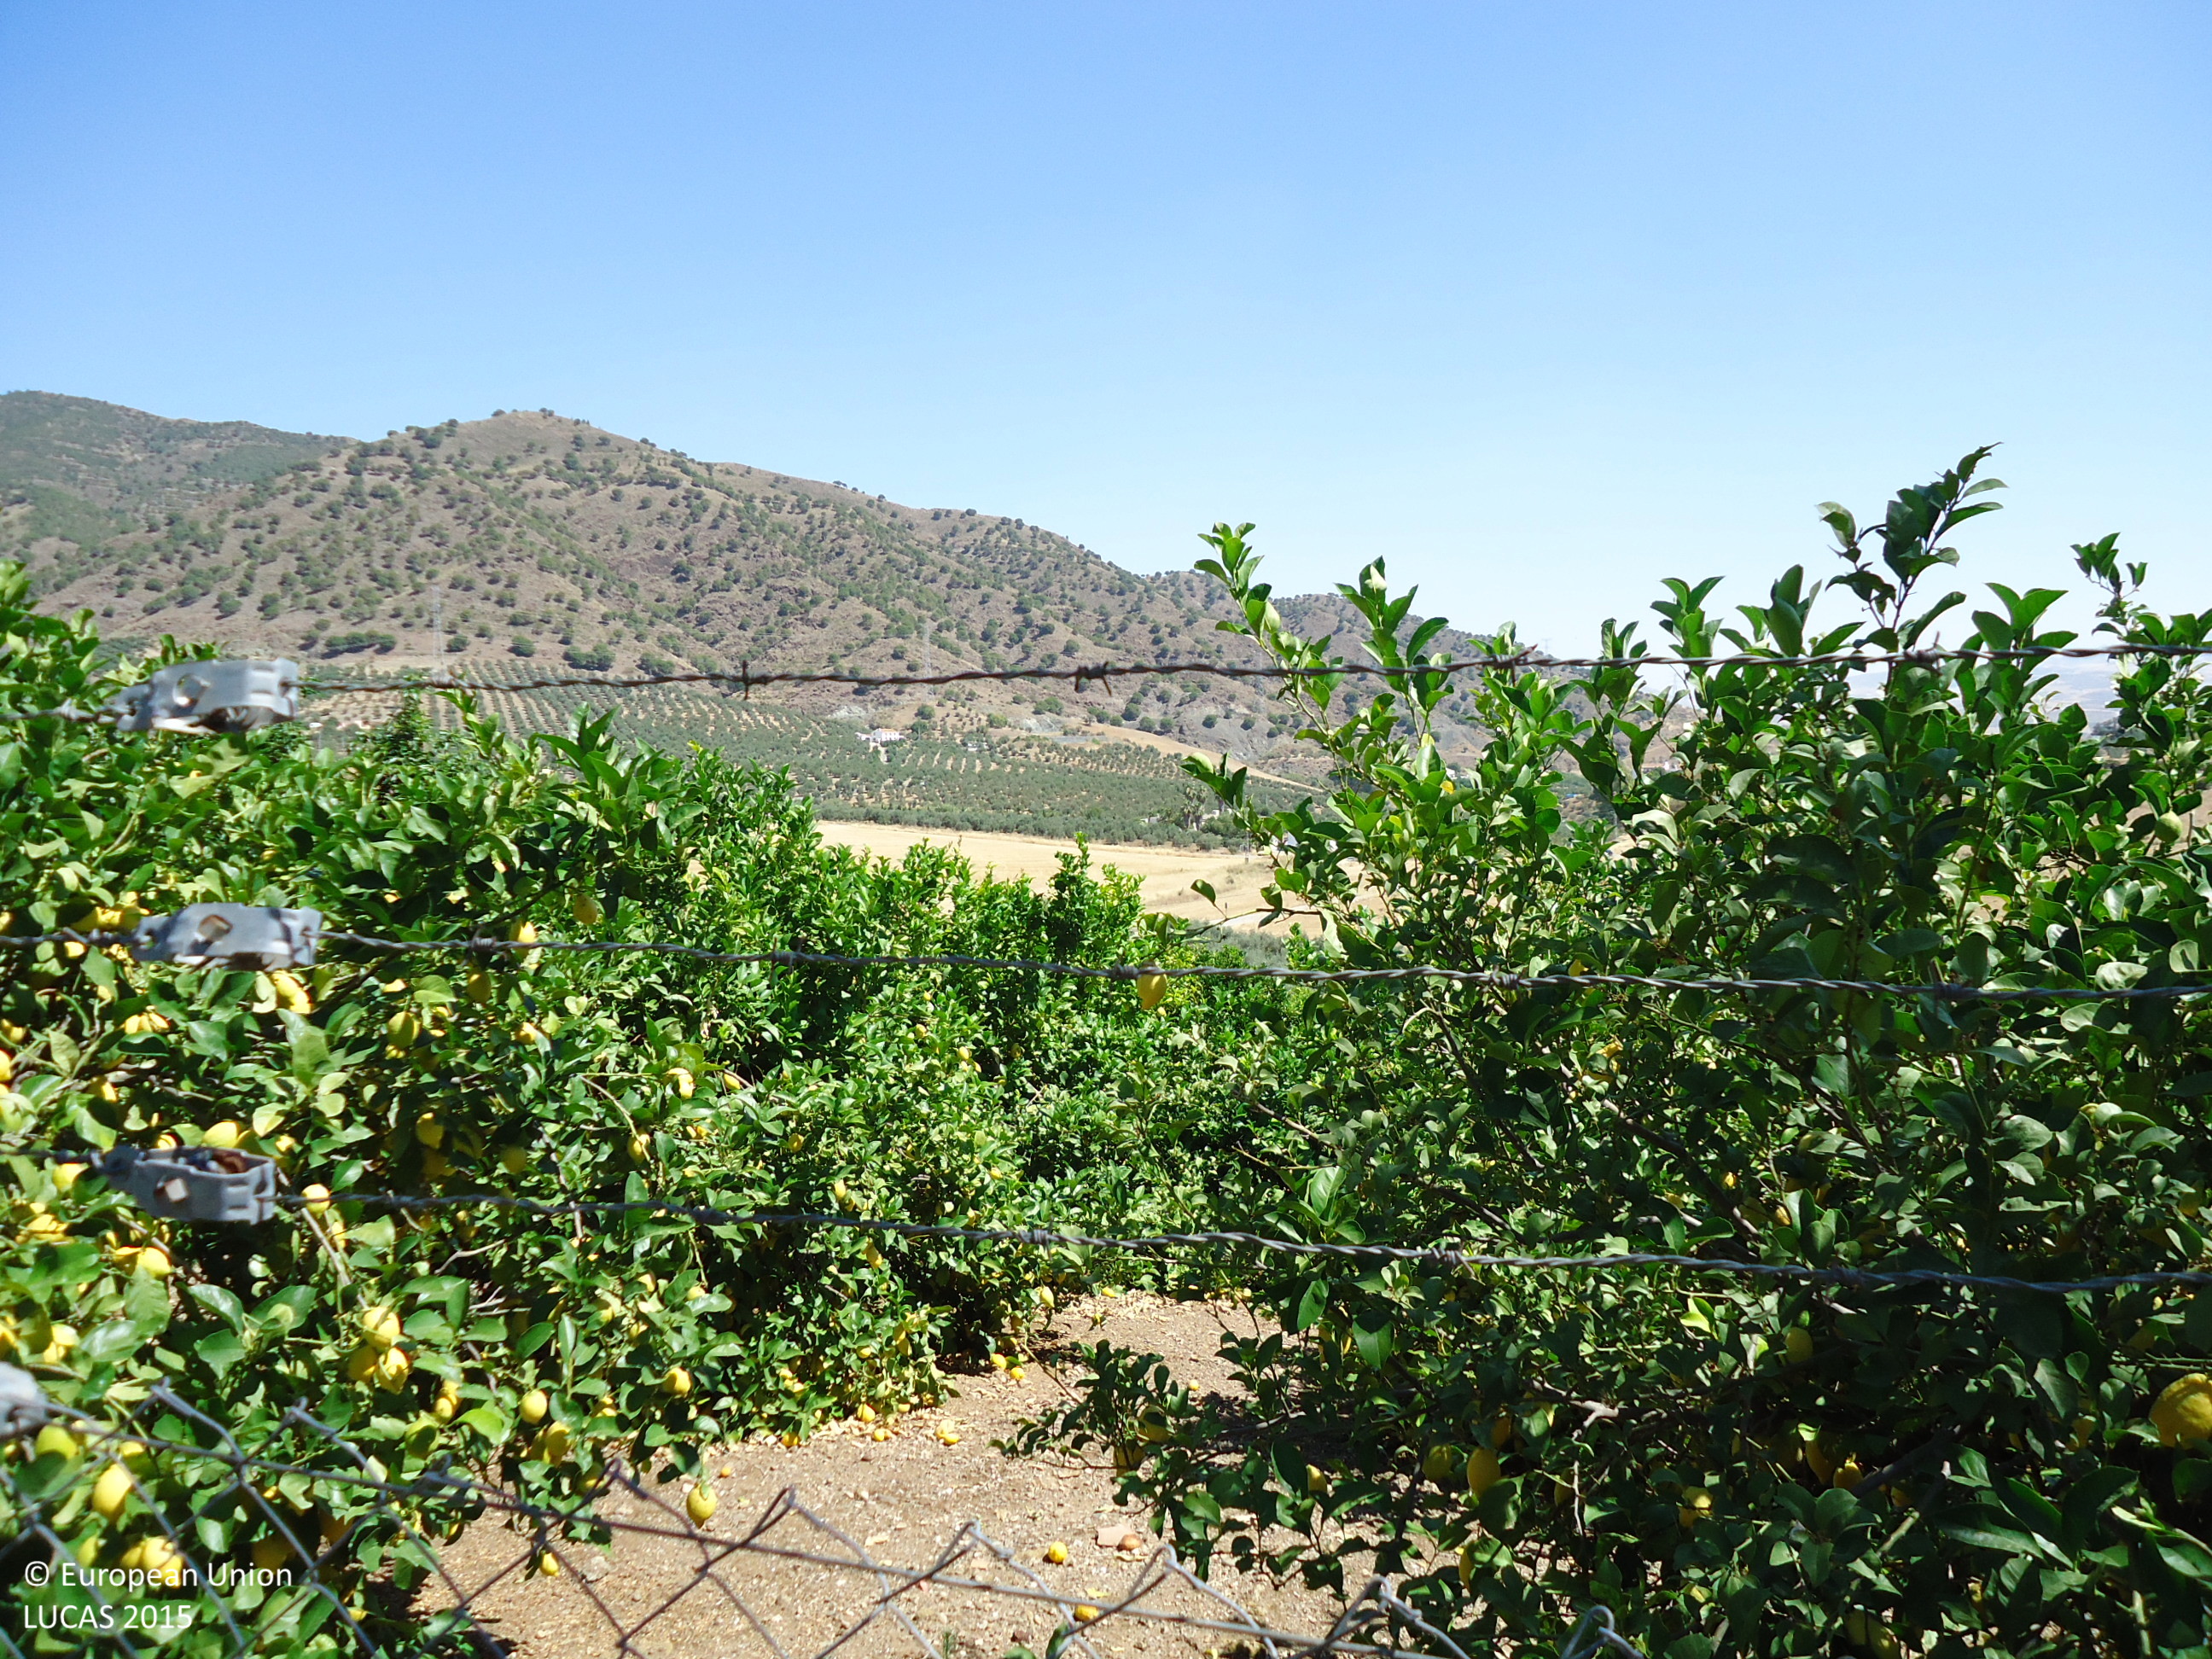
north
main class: Cropland
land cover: Other citrus fruit
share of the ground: > 75 %
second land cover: Other bare soil
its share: > 75 %
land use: Agriculture (excluding fallow land and kitchen gardens)
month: June
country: ES
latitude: 36.8313
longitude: -4.7397
